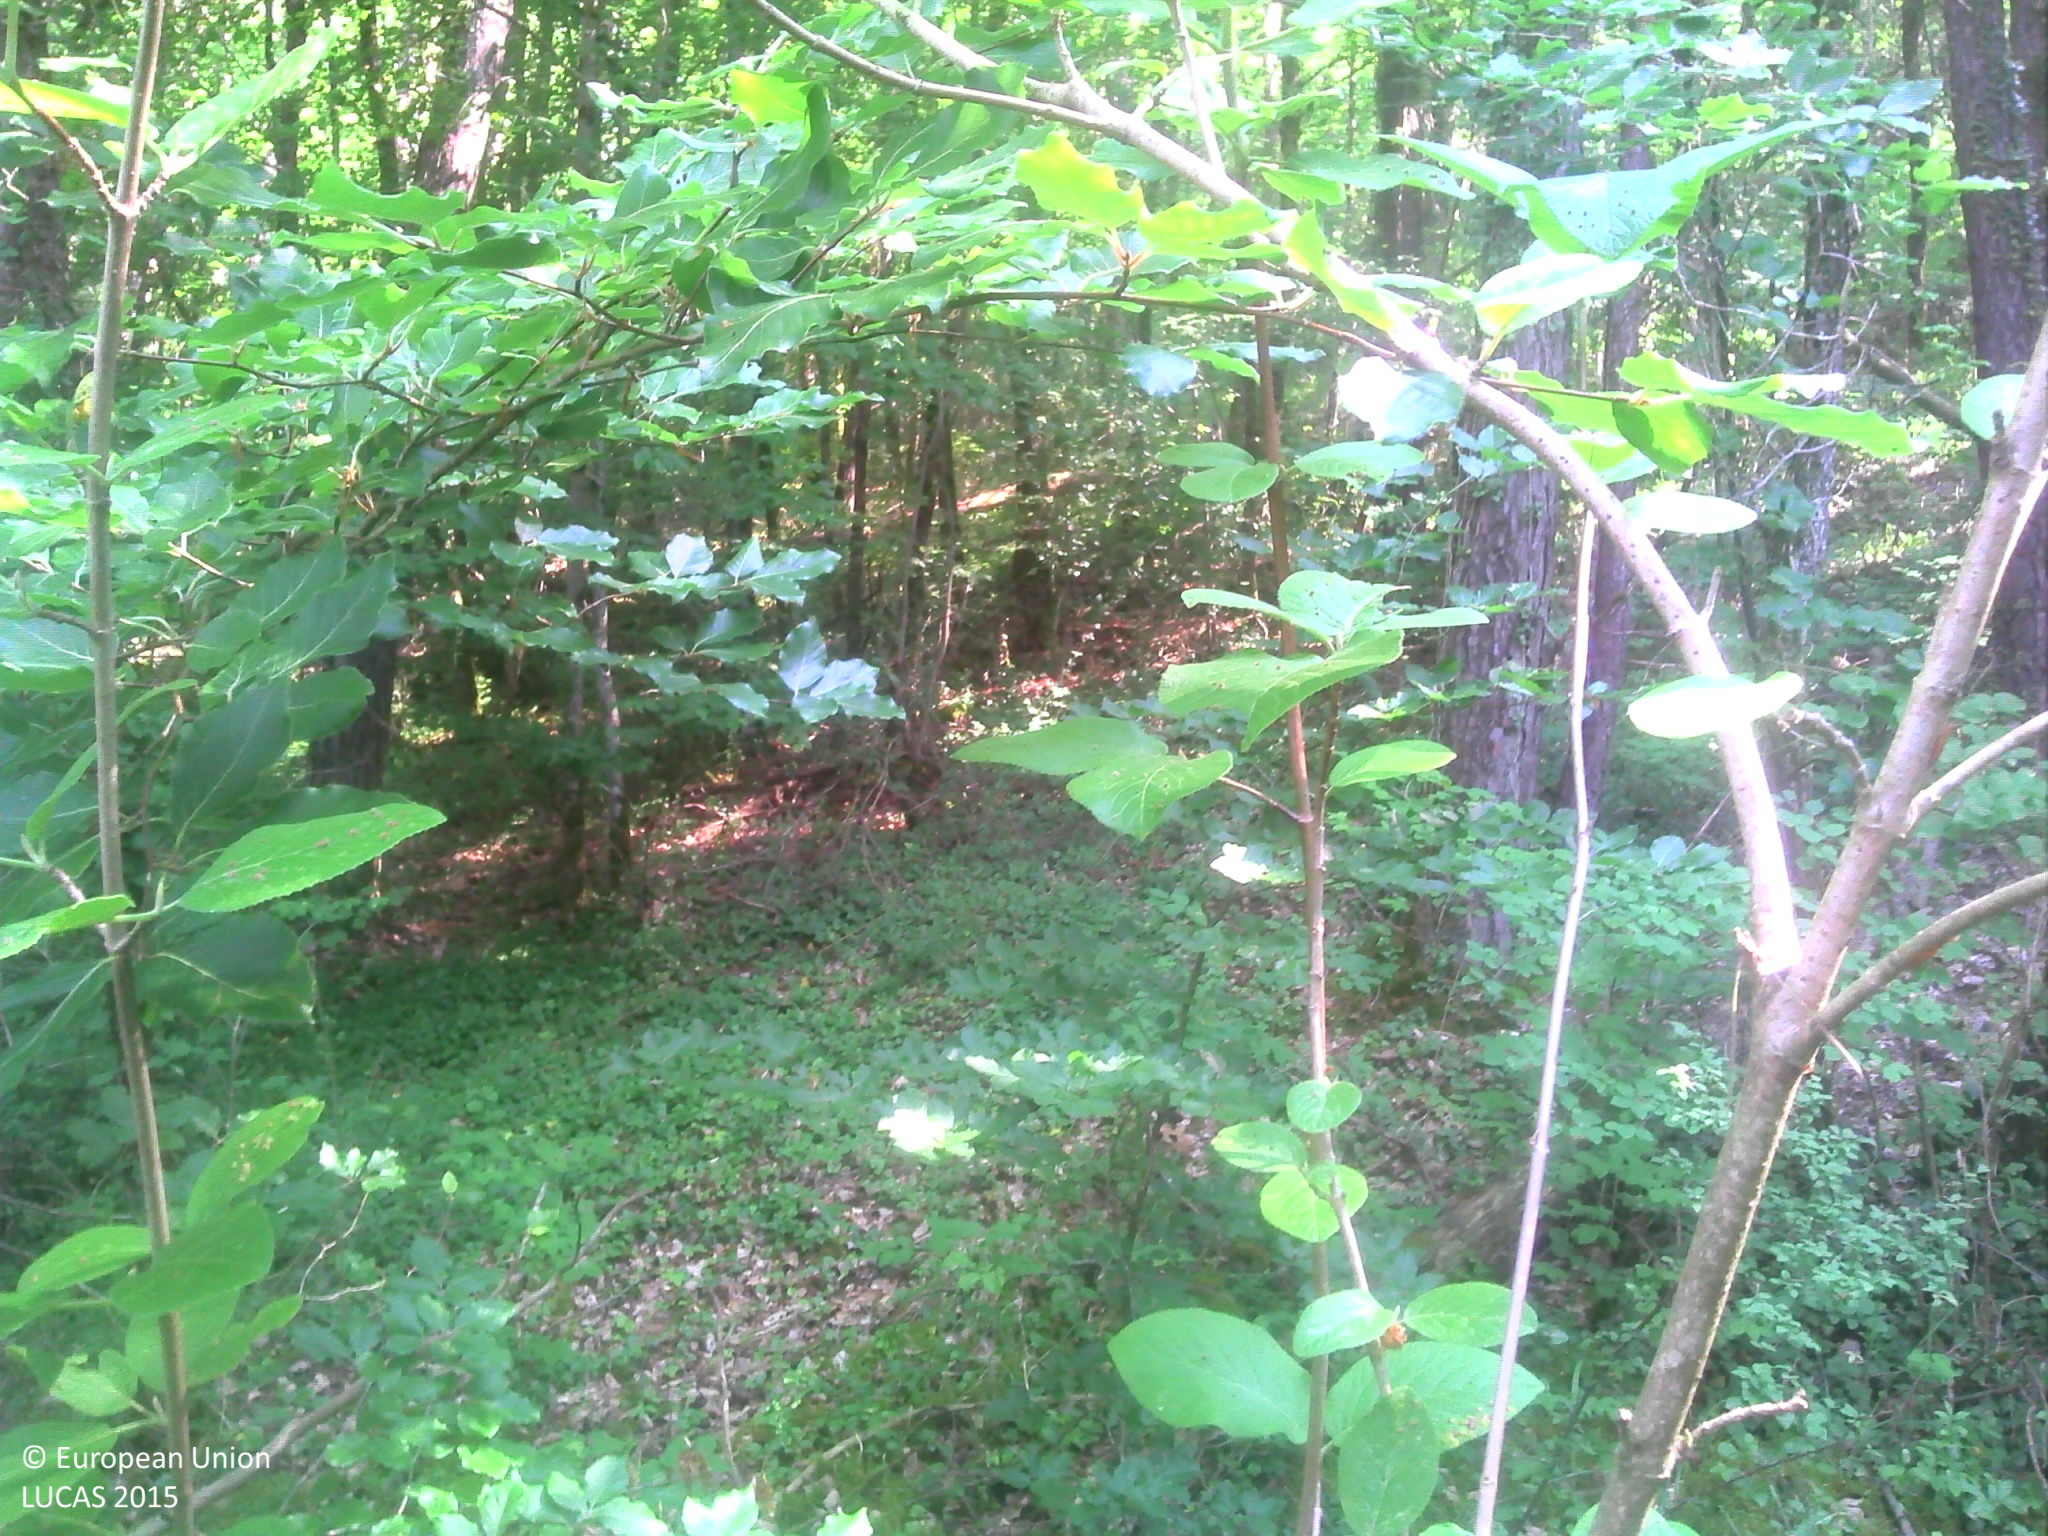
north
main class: Woodland
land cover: Pine dominated coniferous woodland
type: beech forest
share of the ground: > 75 %
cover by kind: coniferous forest trees 70 %, broadleaved forest trees 20 %, herbaceous plants 5 %, lichens and mosses 5 %
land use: Forestry
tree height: > 5 m
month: June
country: FR
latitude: 48.3705
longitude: 5.1797
